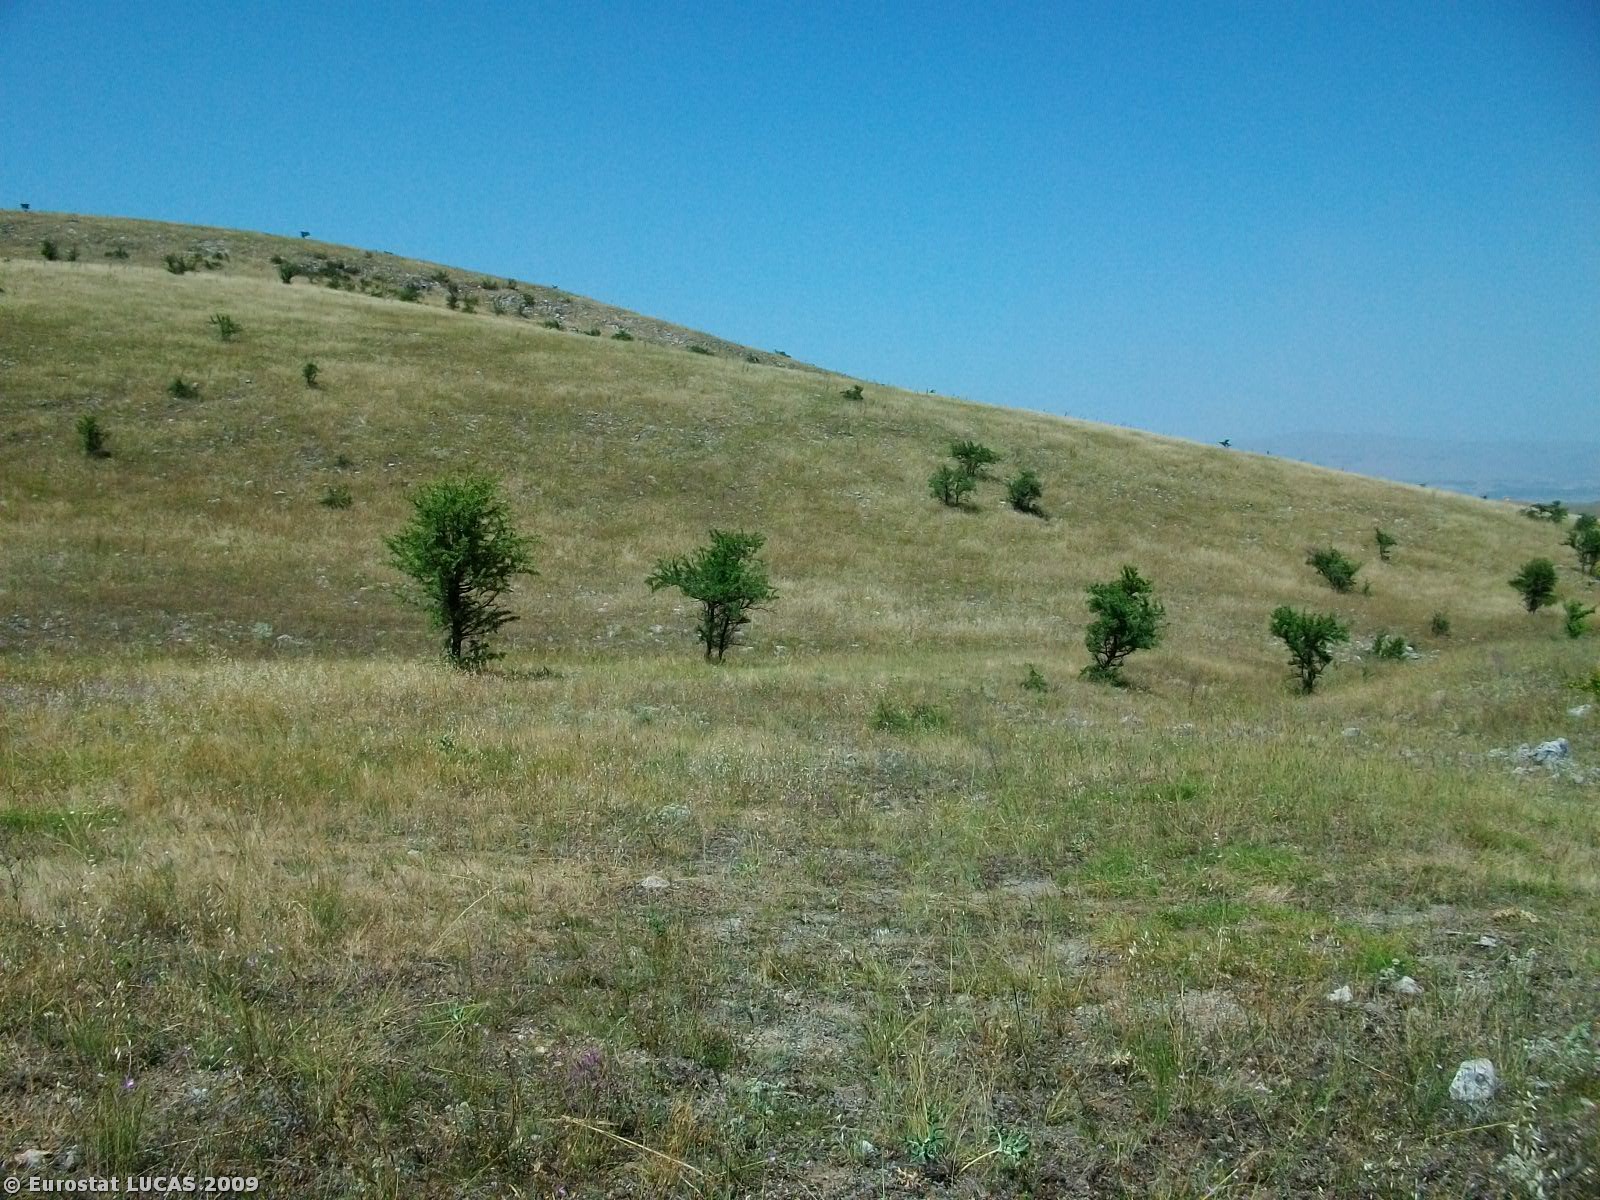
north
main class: Grassland
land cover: Grassland without tree/shrub cover
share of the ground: > 75 %
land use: Unused
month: July
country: GR
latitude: 40.3436
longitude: 21.7527
